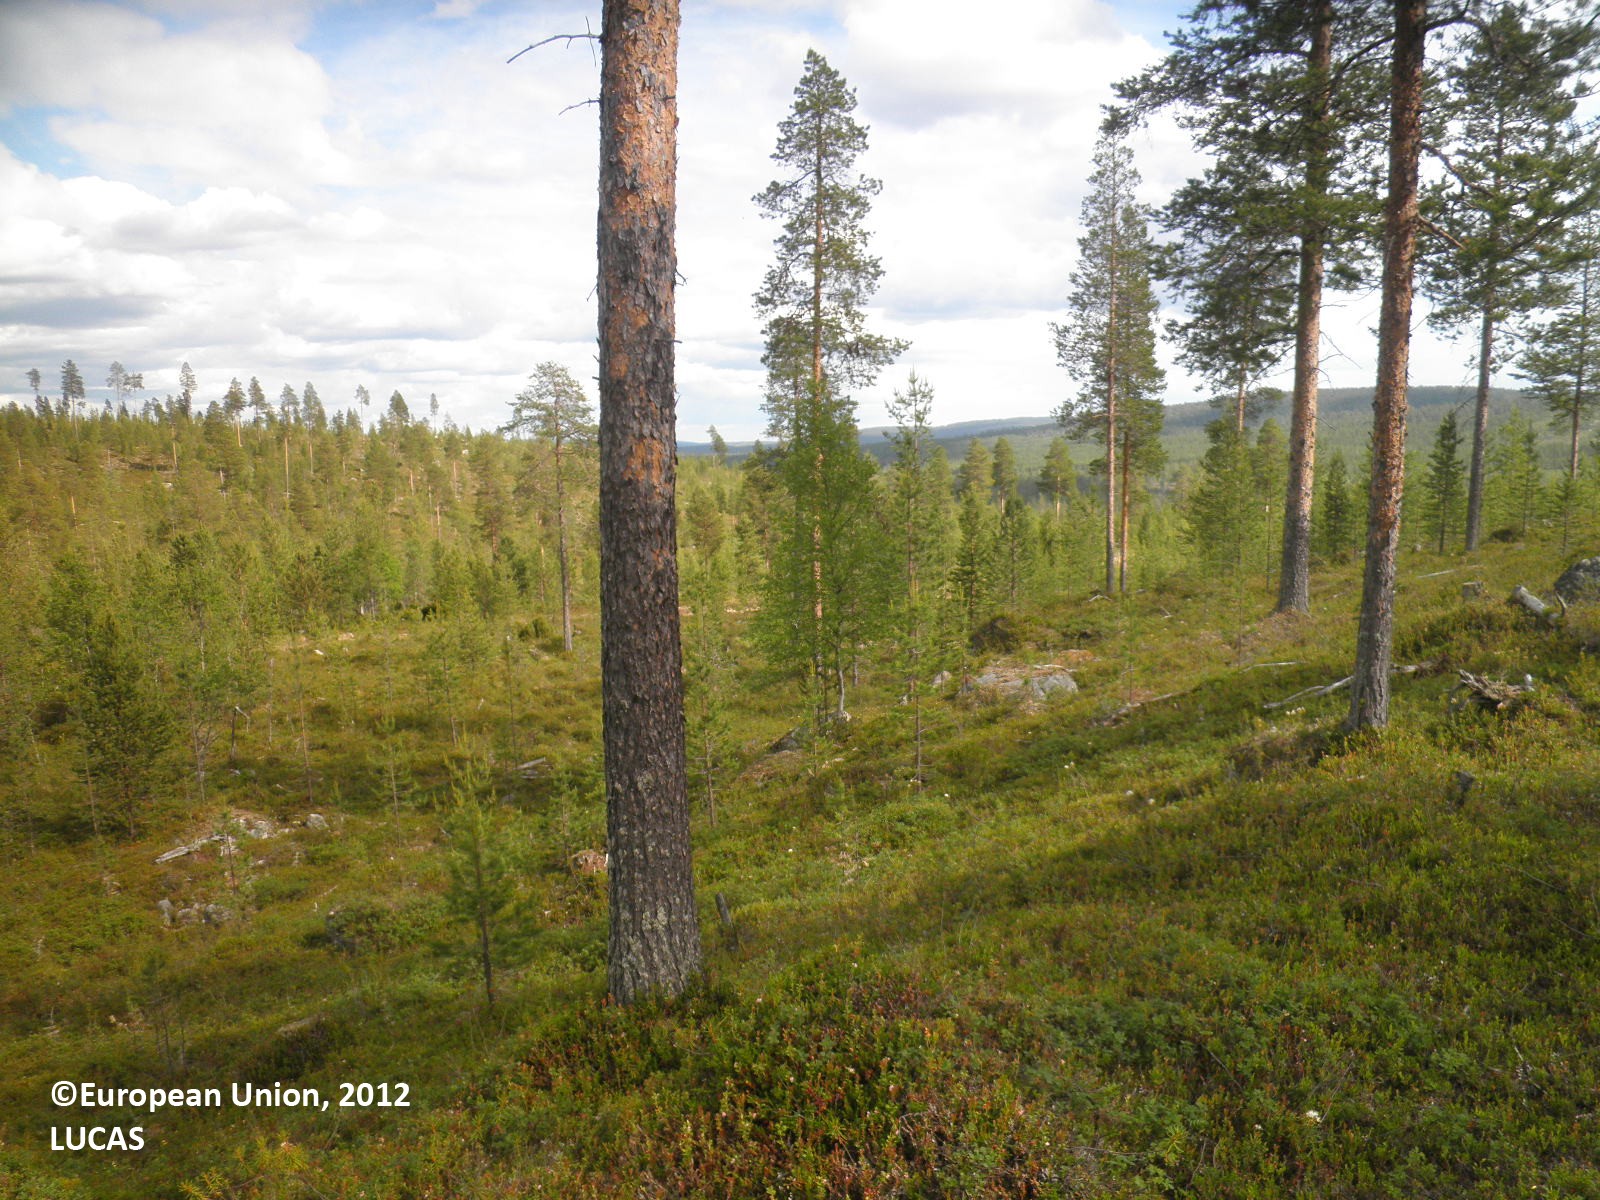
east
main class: Woodland
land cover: Pine dominated coniferous woodland
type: boreal forest
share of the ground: 10 - 25 %
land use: Forestry
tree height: > 5 m
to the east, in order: Pine dominated coniferous woodland; Tracks; Pine dominated coniferous woodland; Rivers and streams; Pine dominated coniferous woodland; Shrubland with sparse tree cover
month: July
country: FI
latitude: 68.6362
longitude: 27.9229
